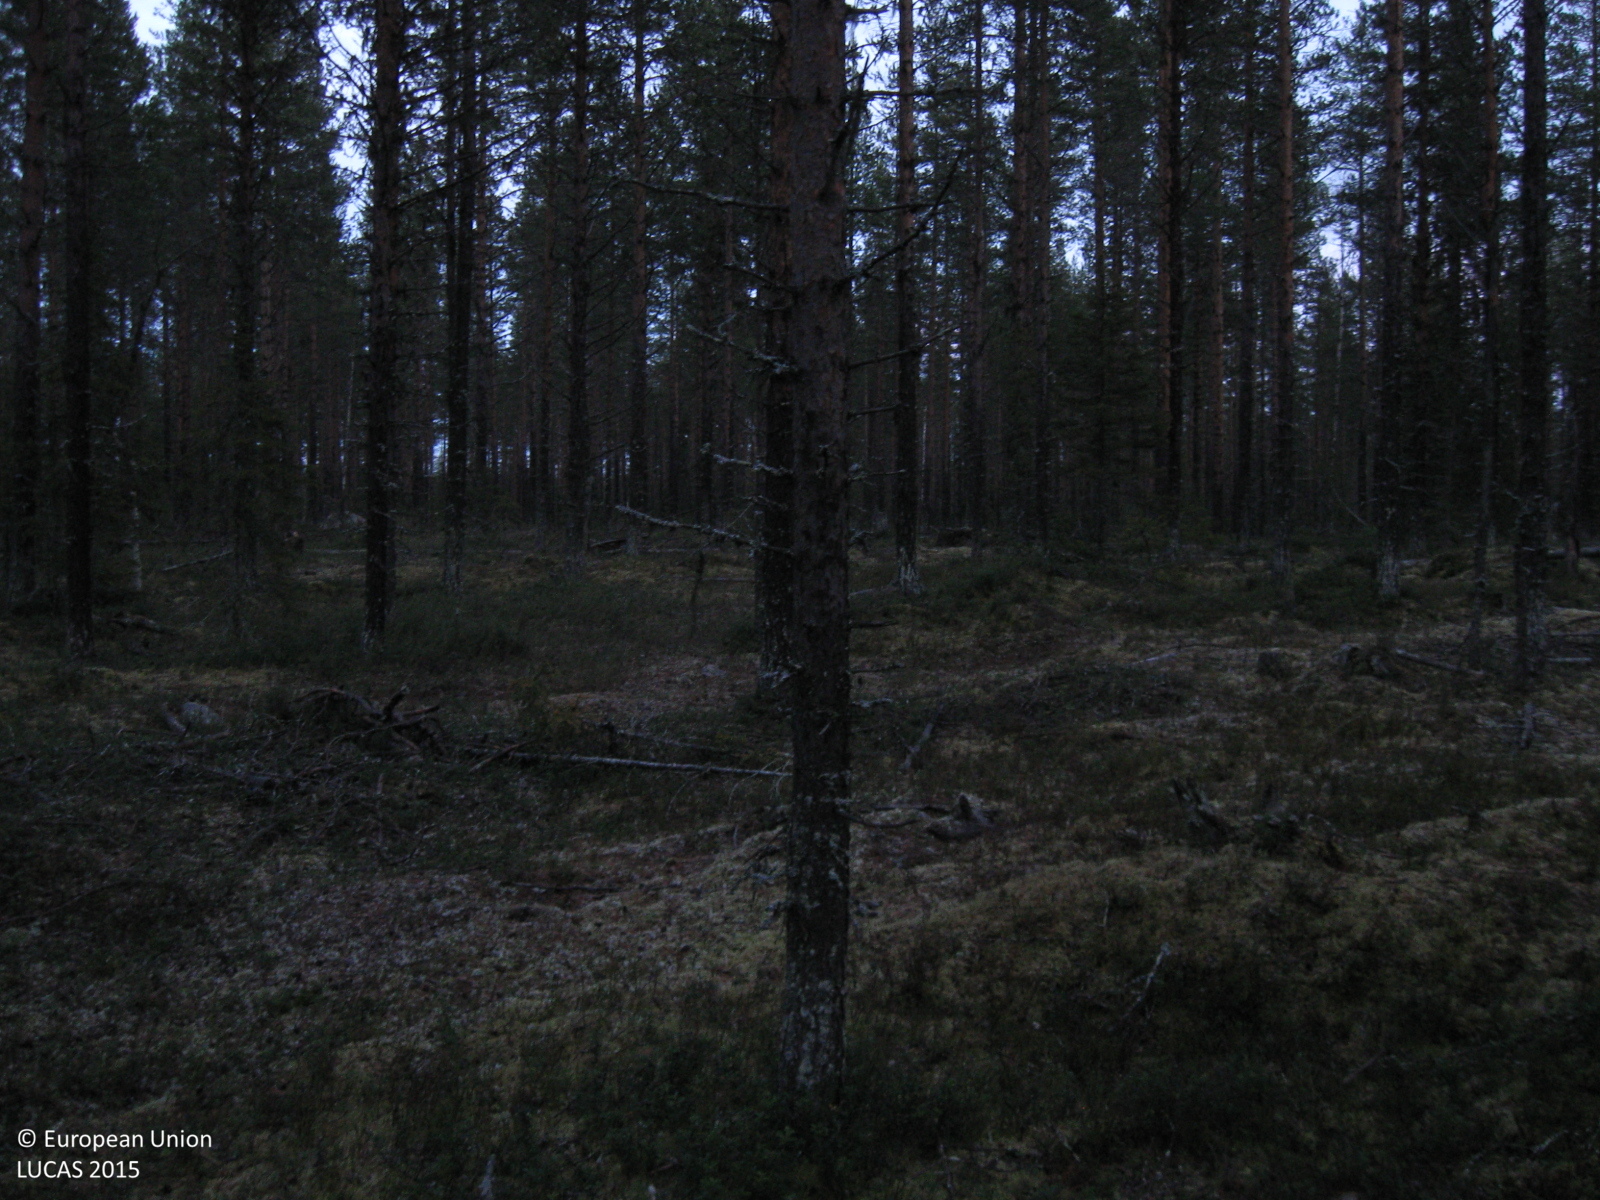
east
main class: Woodland
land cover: Pine dominated coniferous woodland
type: boreal forest
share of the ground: > 75 %
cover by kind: coniferous forest trees 75 %, shrubs 10 %, lichens and mosses 10 %, herbaceous plants 5 %
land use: Forestry
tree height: > 5 m
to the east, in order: Pine dominated coniferous woodland; Other coniferous woodland; Pine dominated coniferous woodland
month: October
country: SE
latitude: 66.5502
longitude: 21.1062
